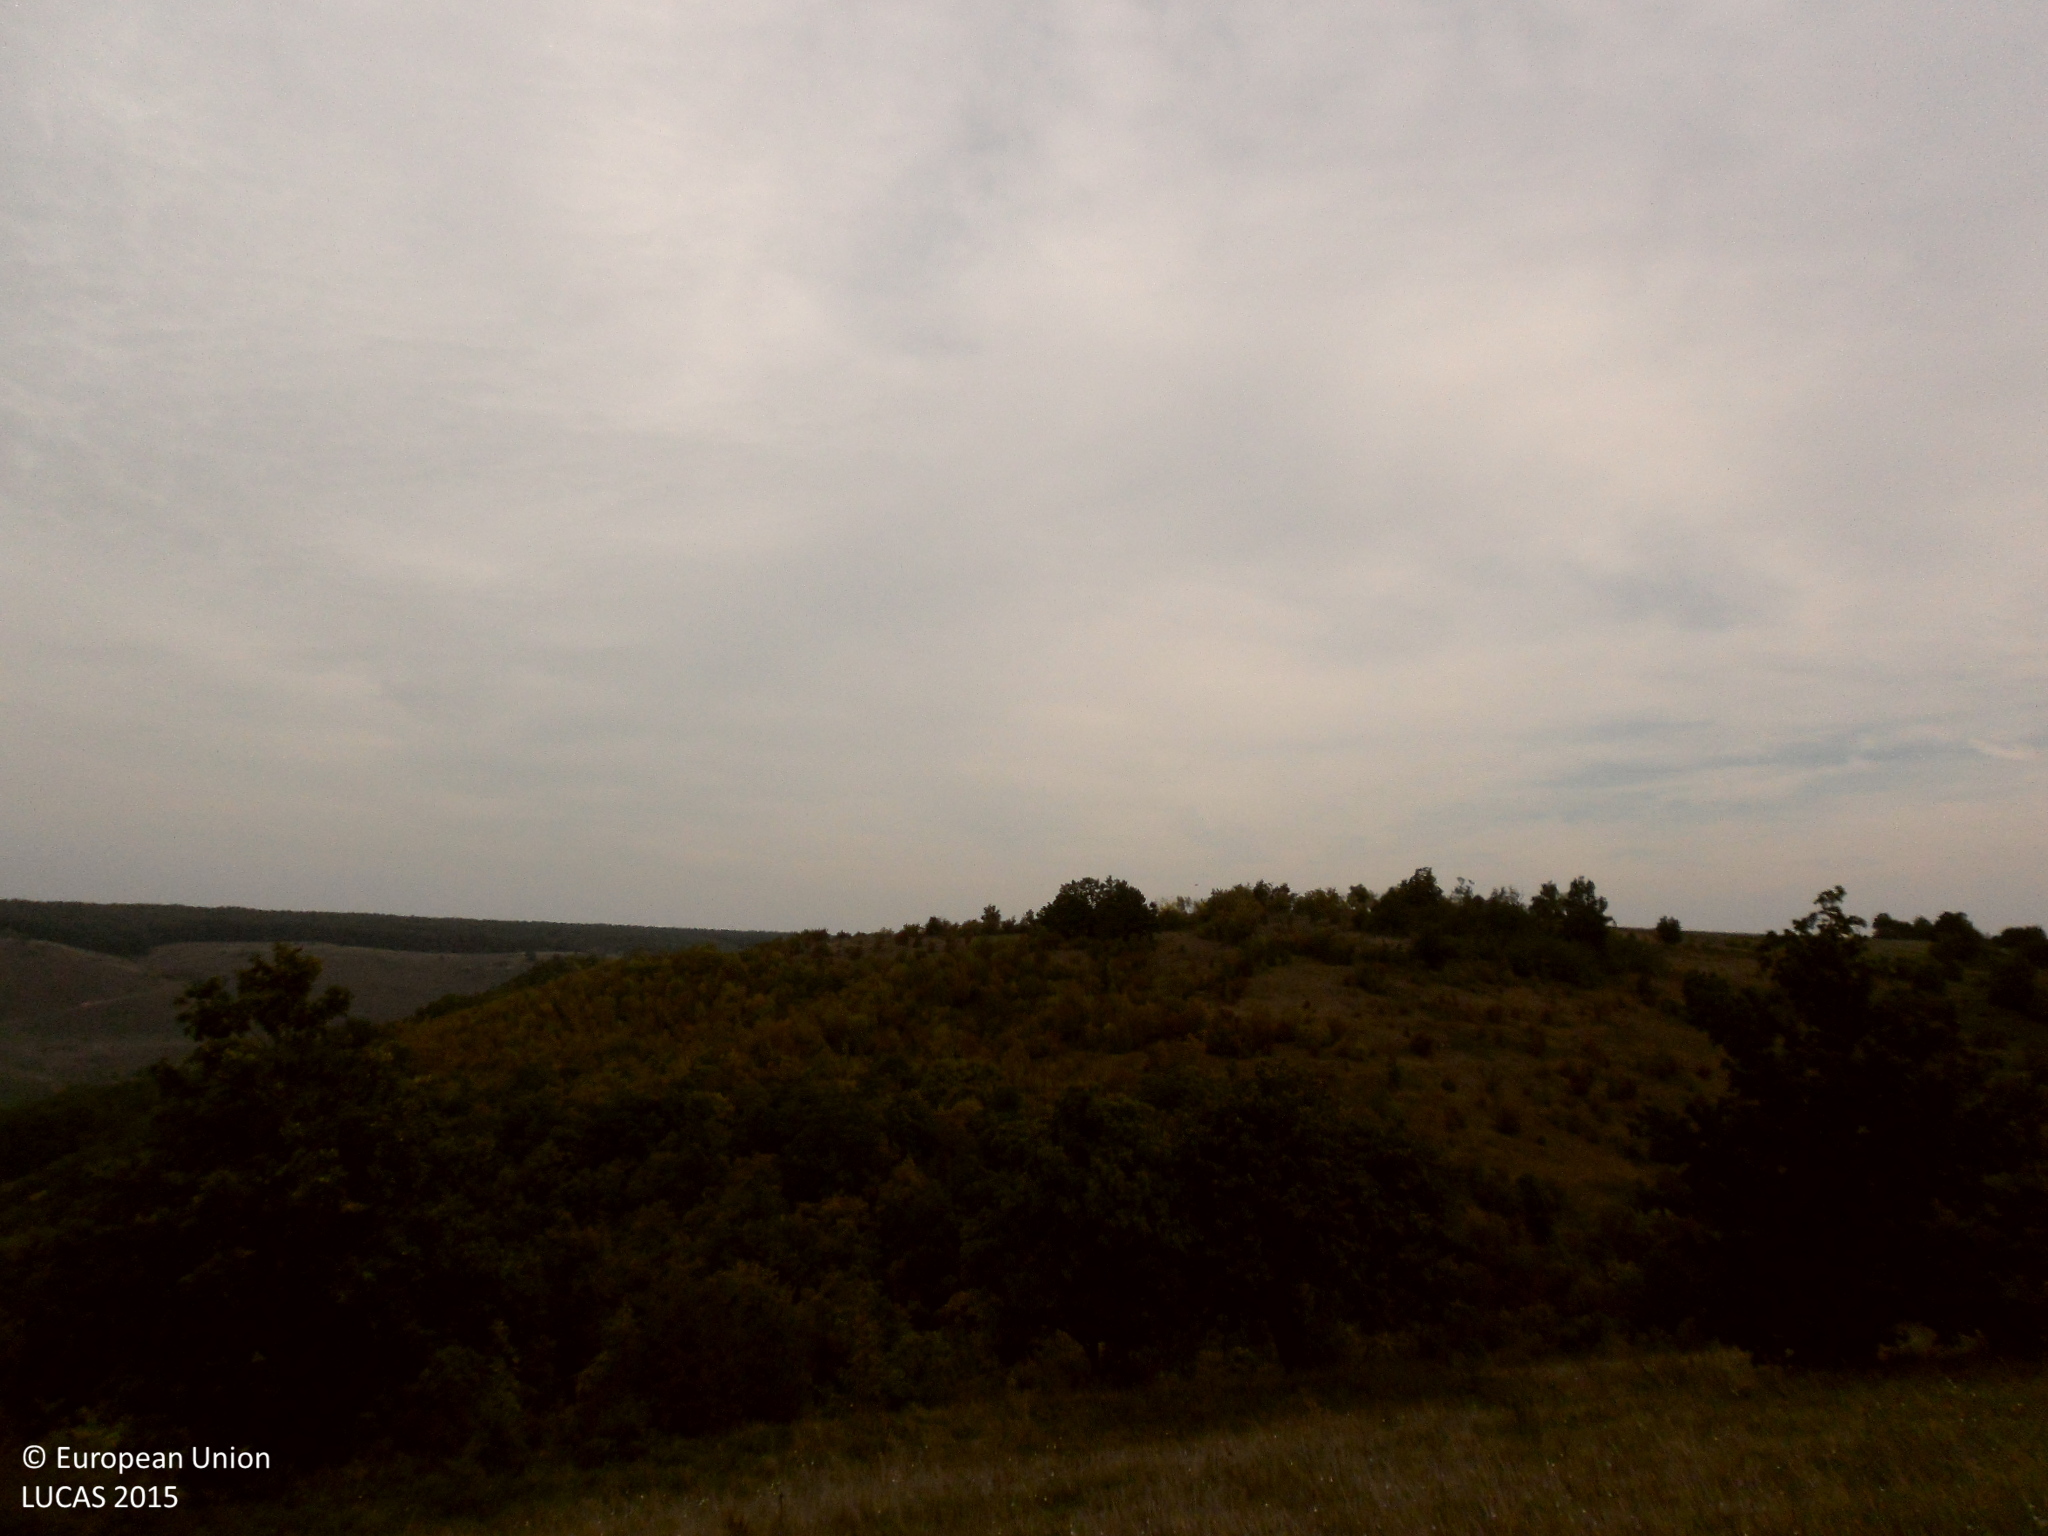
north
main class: Grassland
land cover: Grassland with sparse tree/shrub cover
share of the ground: > 75 %
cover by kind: herbaceous plants 90 %, broadleaved forest trees 5 %, shrubs 5 %
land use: Semi-natural and natural areas not in use
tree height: > 5 m
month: October
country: BG
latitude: 43.9963
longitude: 22.6184
